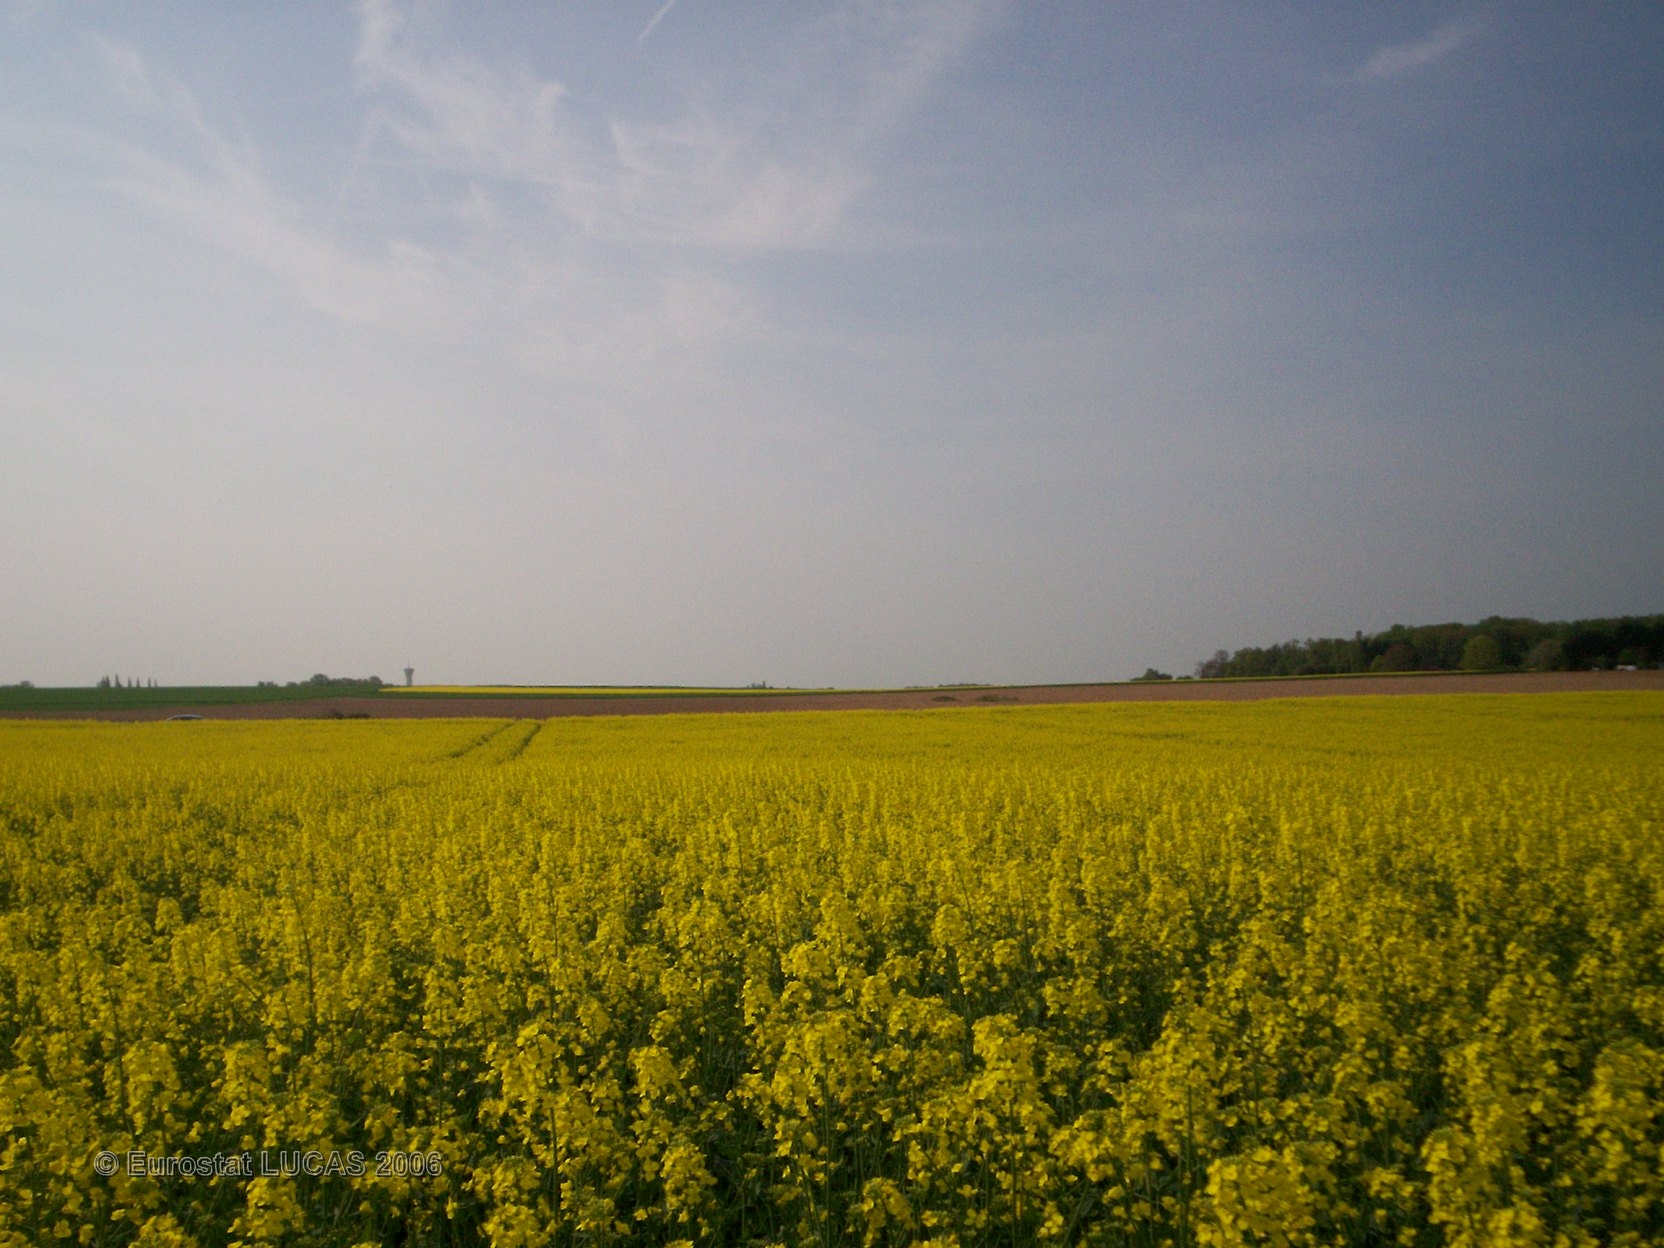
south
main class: Cropland
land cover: Rape and turnip rape
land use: Agriculture (excluding fallow land and kitchen gardens)
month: May
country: FR
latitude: 48.0859
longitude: 2.9175
